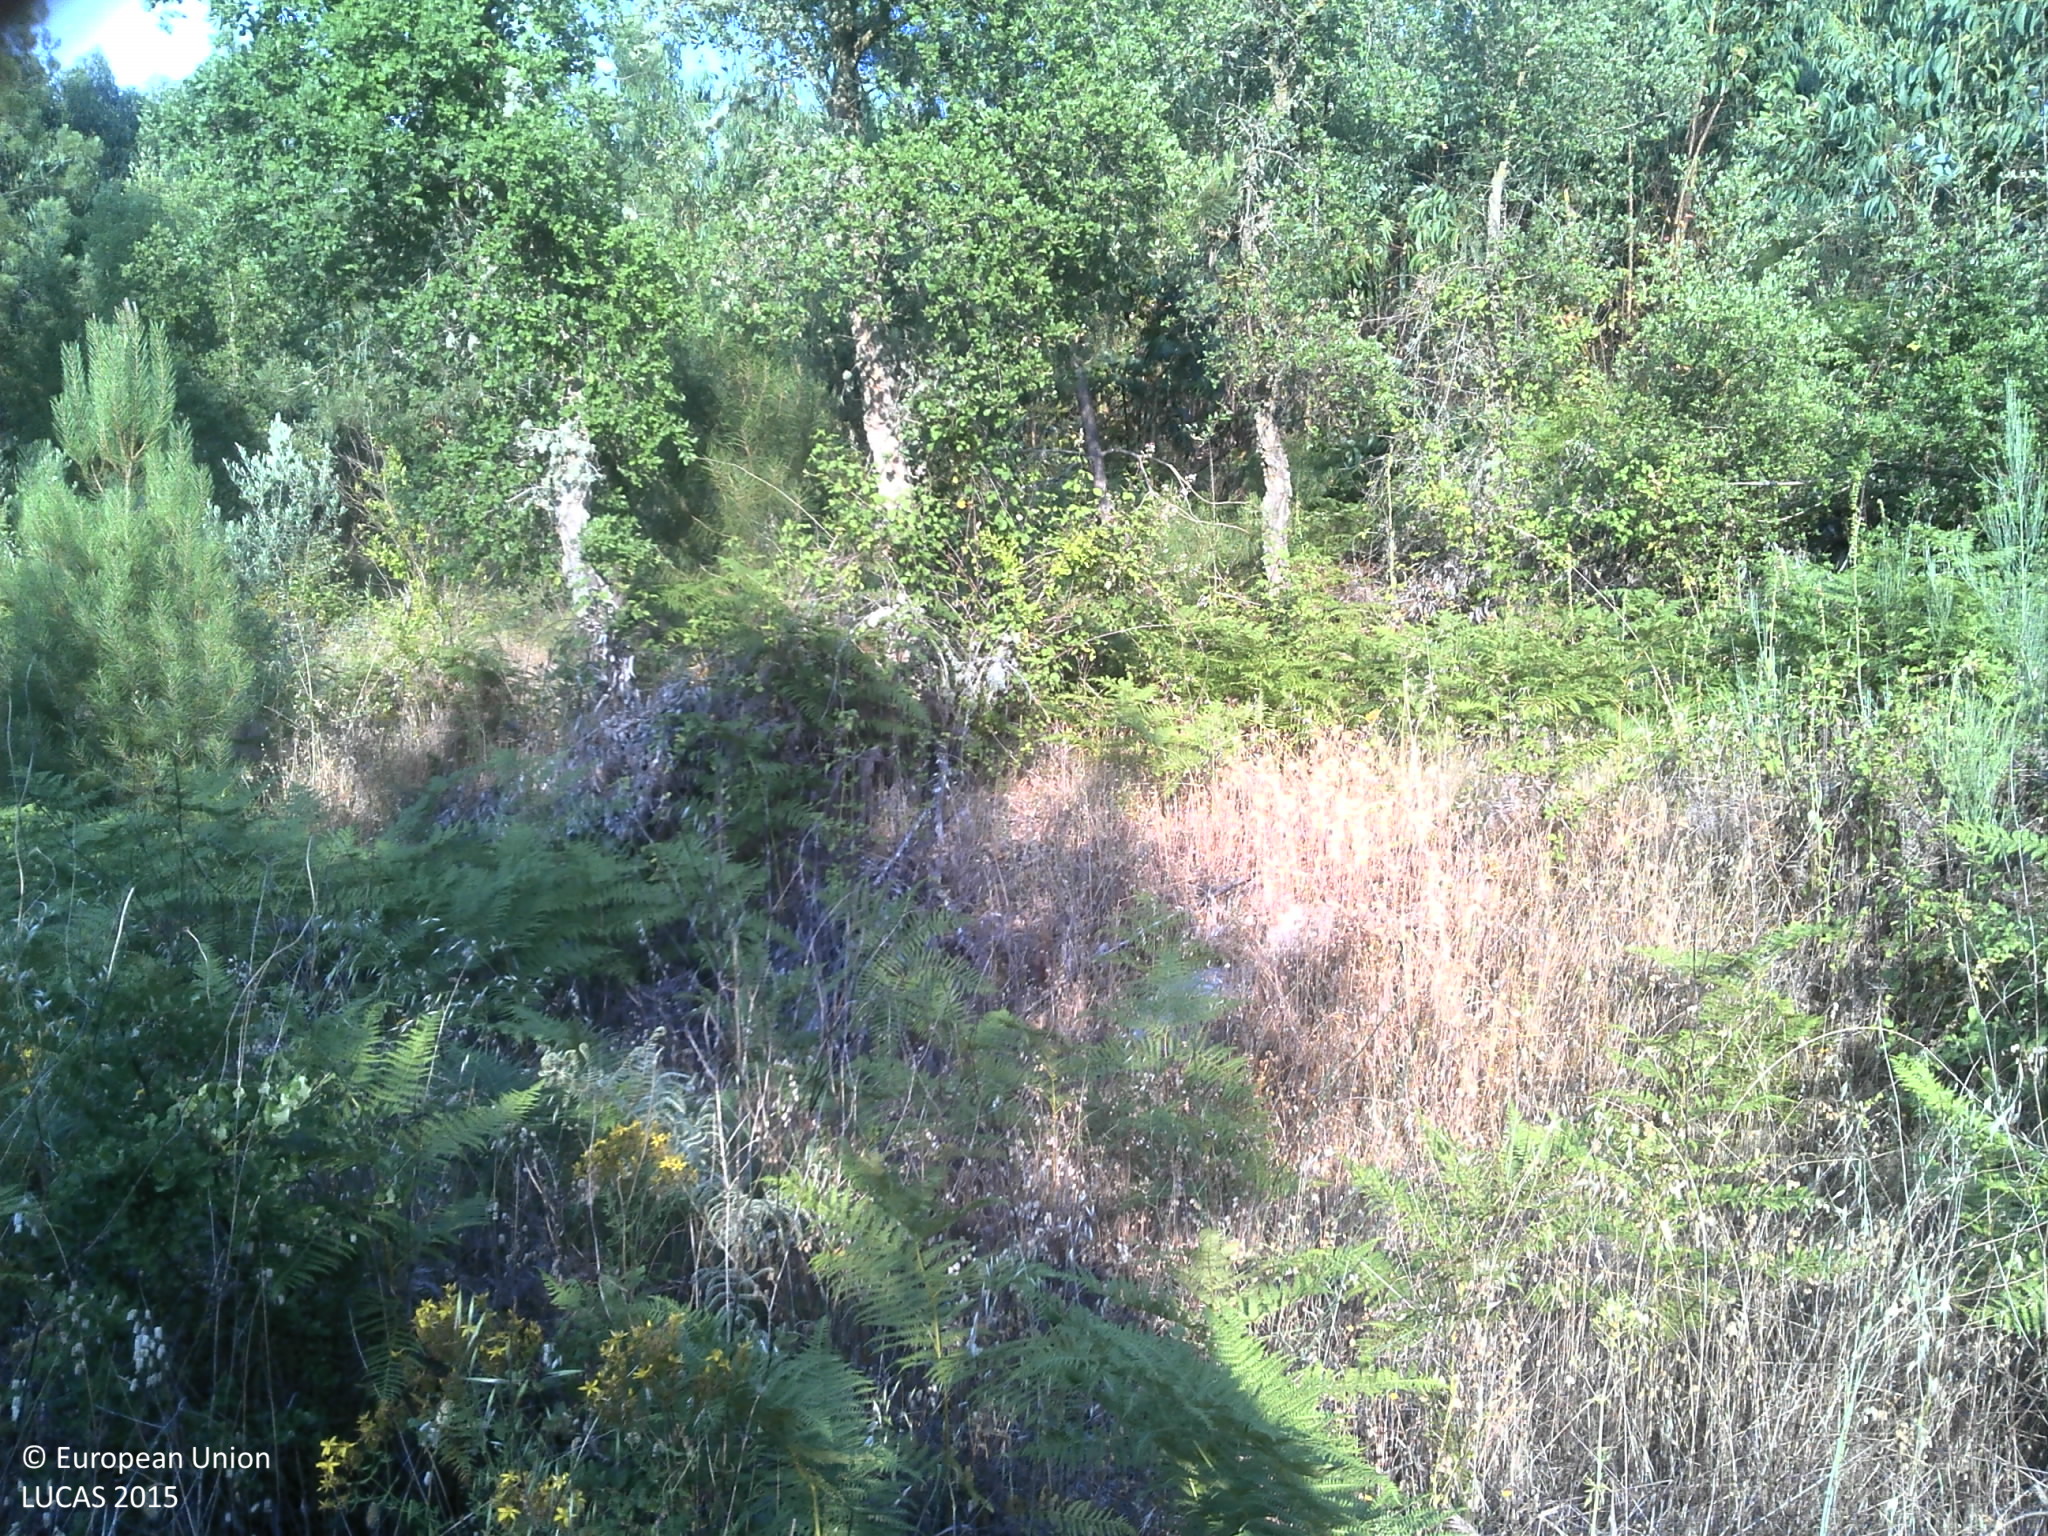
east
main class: Cropland
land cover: Olive groves
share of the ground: 25 - 50 %
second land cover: Shrubland without tree cover
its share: 50 - 75 %
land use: Agriculture (excluding fallow land and kitchen gardens)
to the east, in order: Olive groves; Shrubland without tree cover; Shrubland with sparse tree cover; Broadleaved woodland; Pine dominated coniferous woodland; Pine dominated mixed woodland; Shrubland with sparse tree cover; Broadleaved woodland
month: June
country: PT
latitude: 39.3654
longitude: -7.9887
